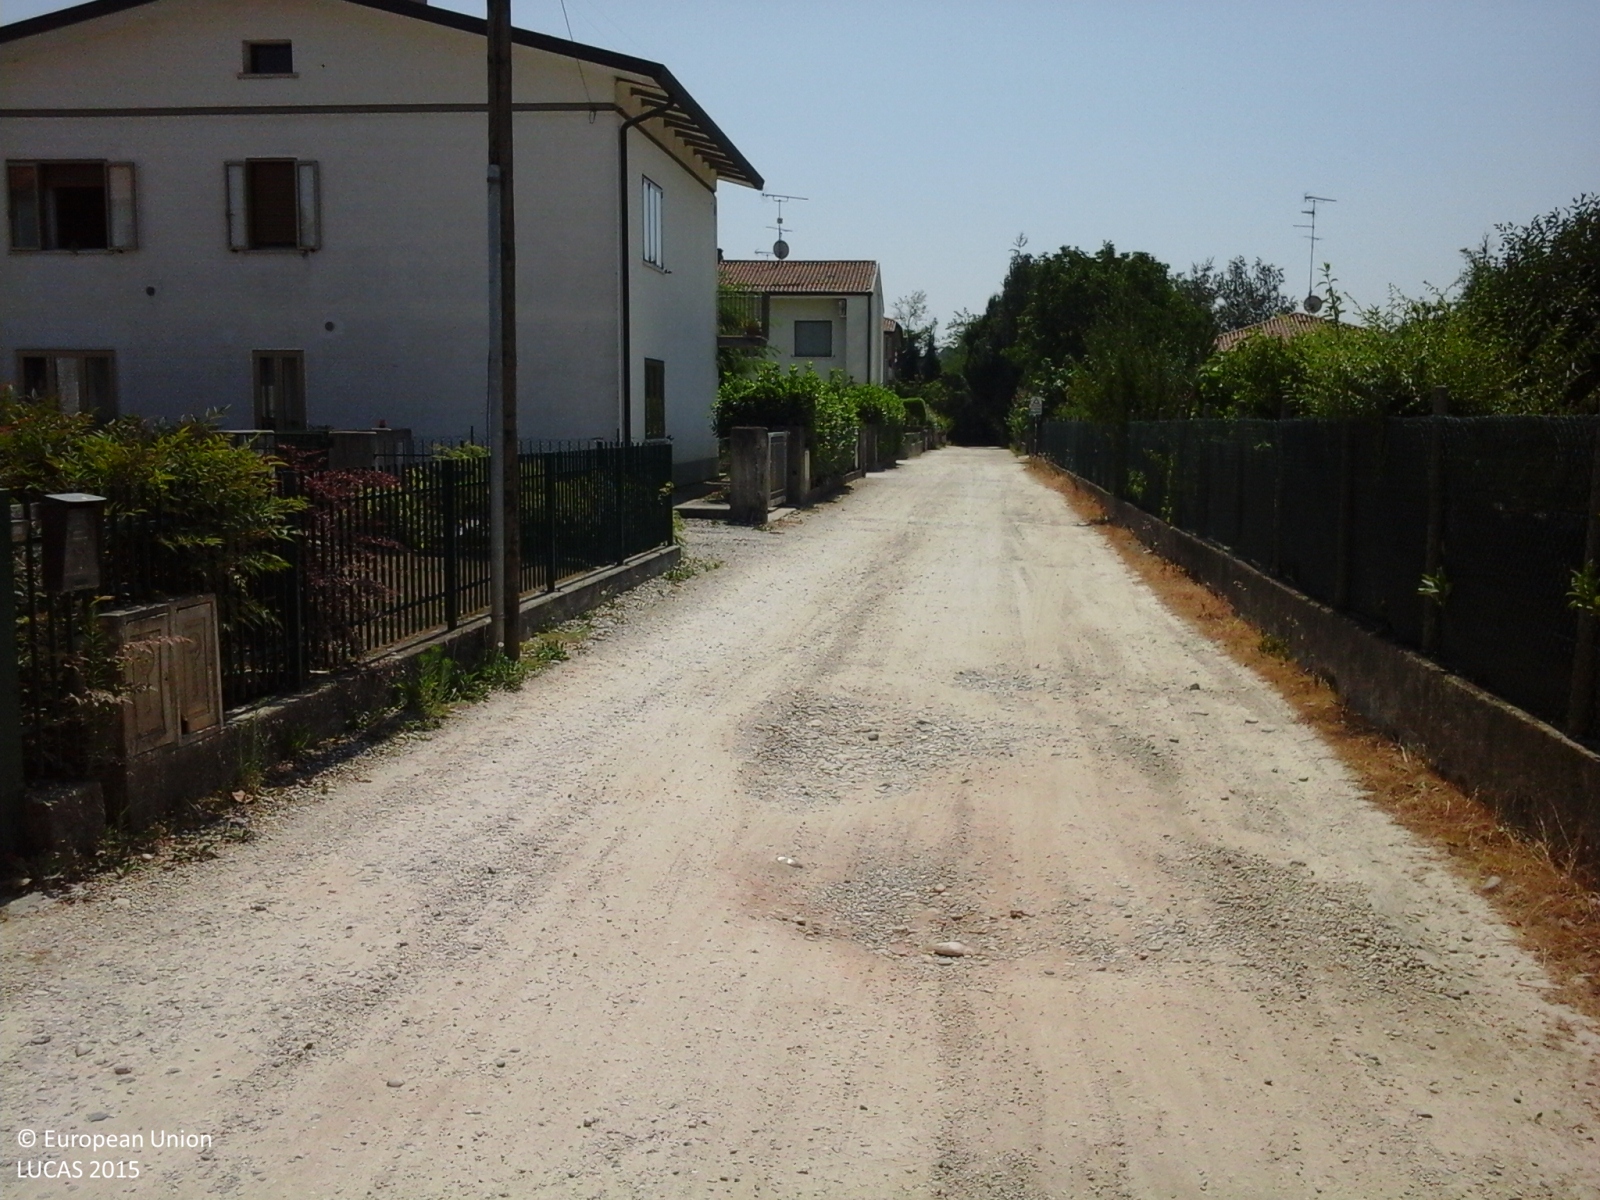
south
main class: Woodland
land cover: Broadleaved woodland
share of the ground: > 75 %
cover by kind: broadleaved forest trees 80 %, herbaceous plants 20 %
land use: Residential
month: July
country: IT
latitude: 45.8606
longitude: 12.1737
